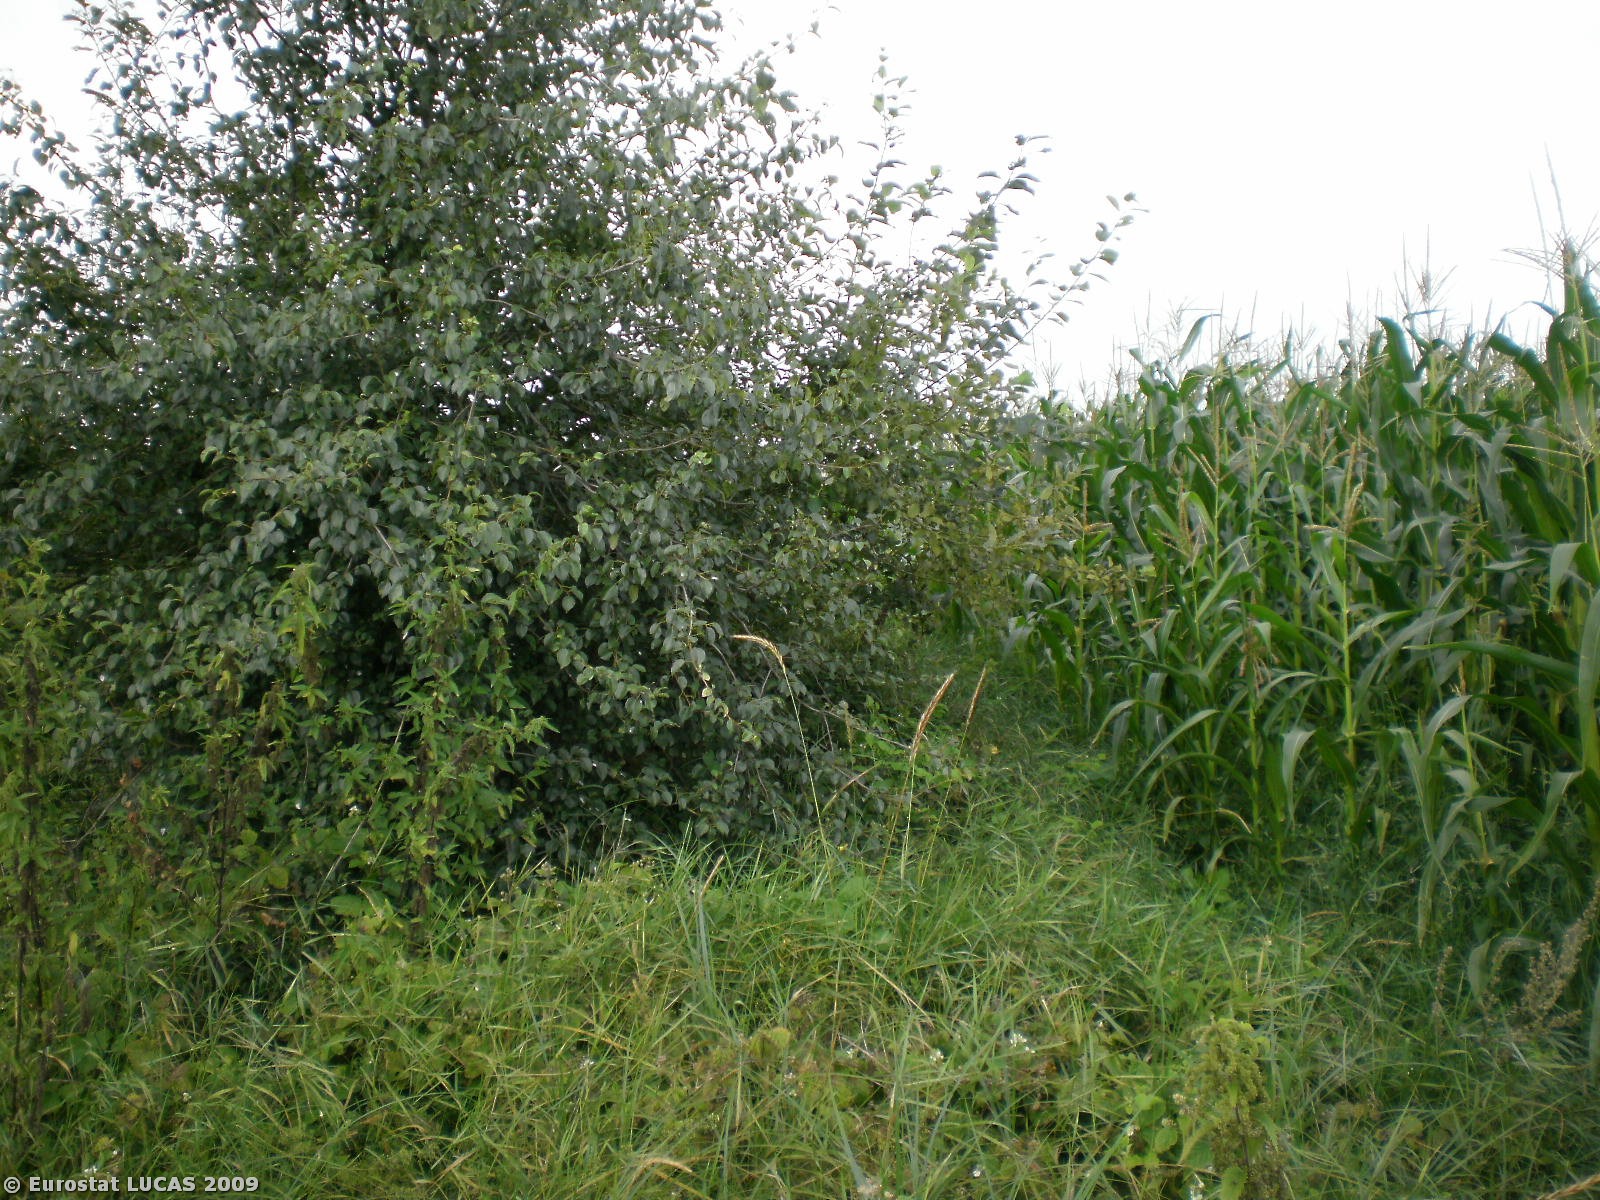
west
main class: Cropland
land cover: Maize
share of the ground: > 75 %
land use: Agriculture (excluding fallow land and kitchen gardens)
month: August
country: PL
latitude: 53.0179
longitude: 21.8469
